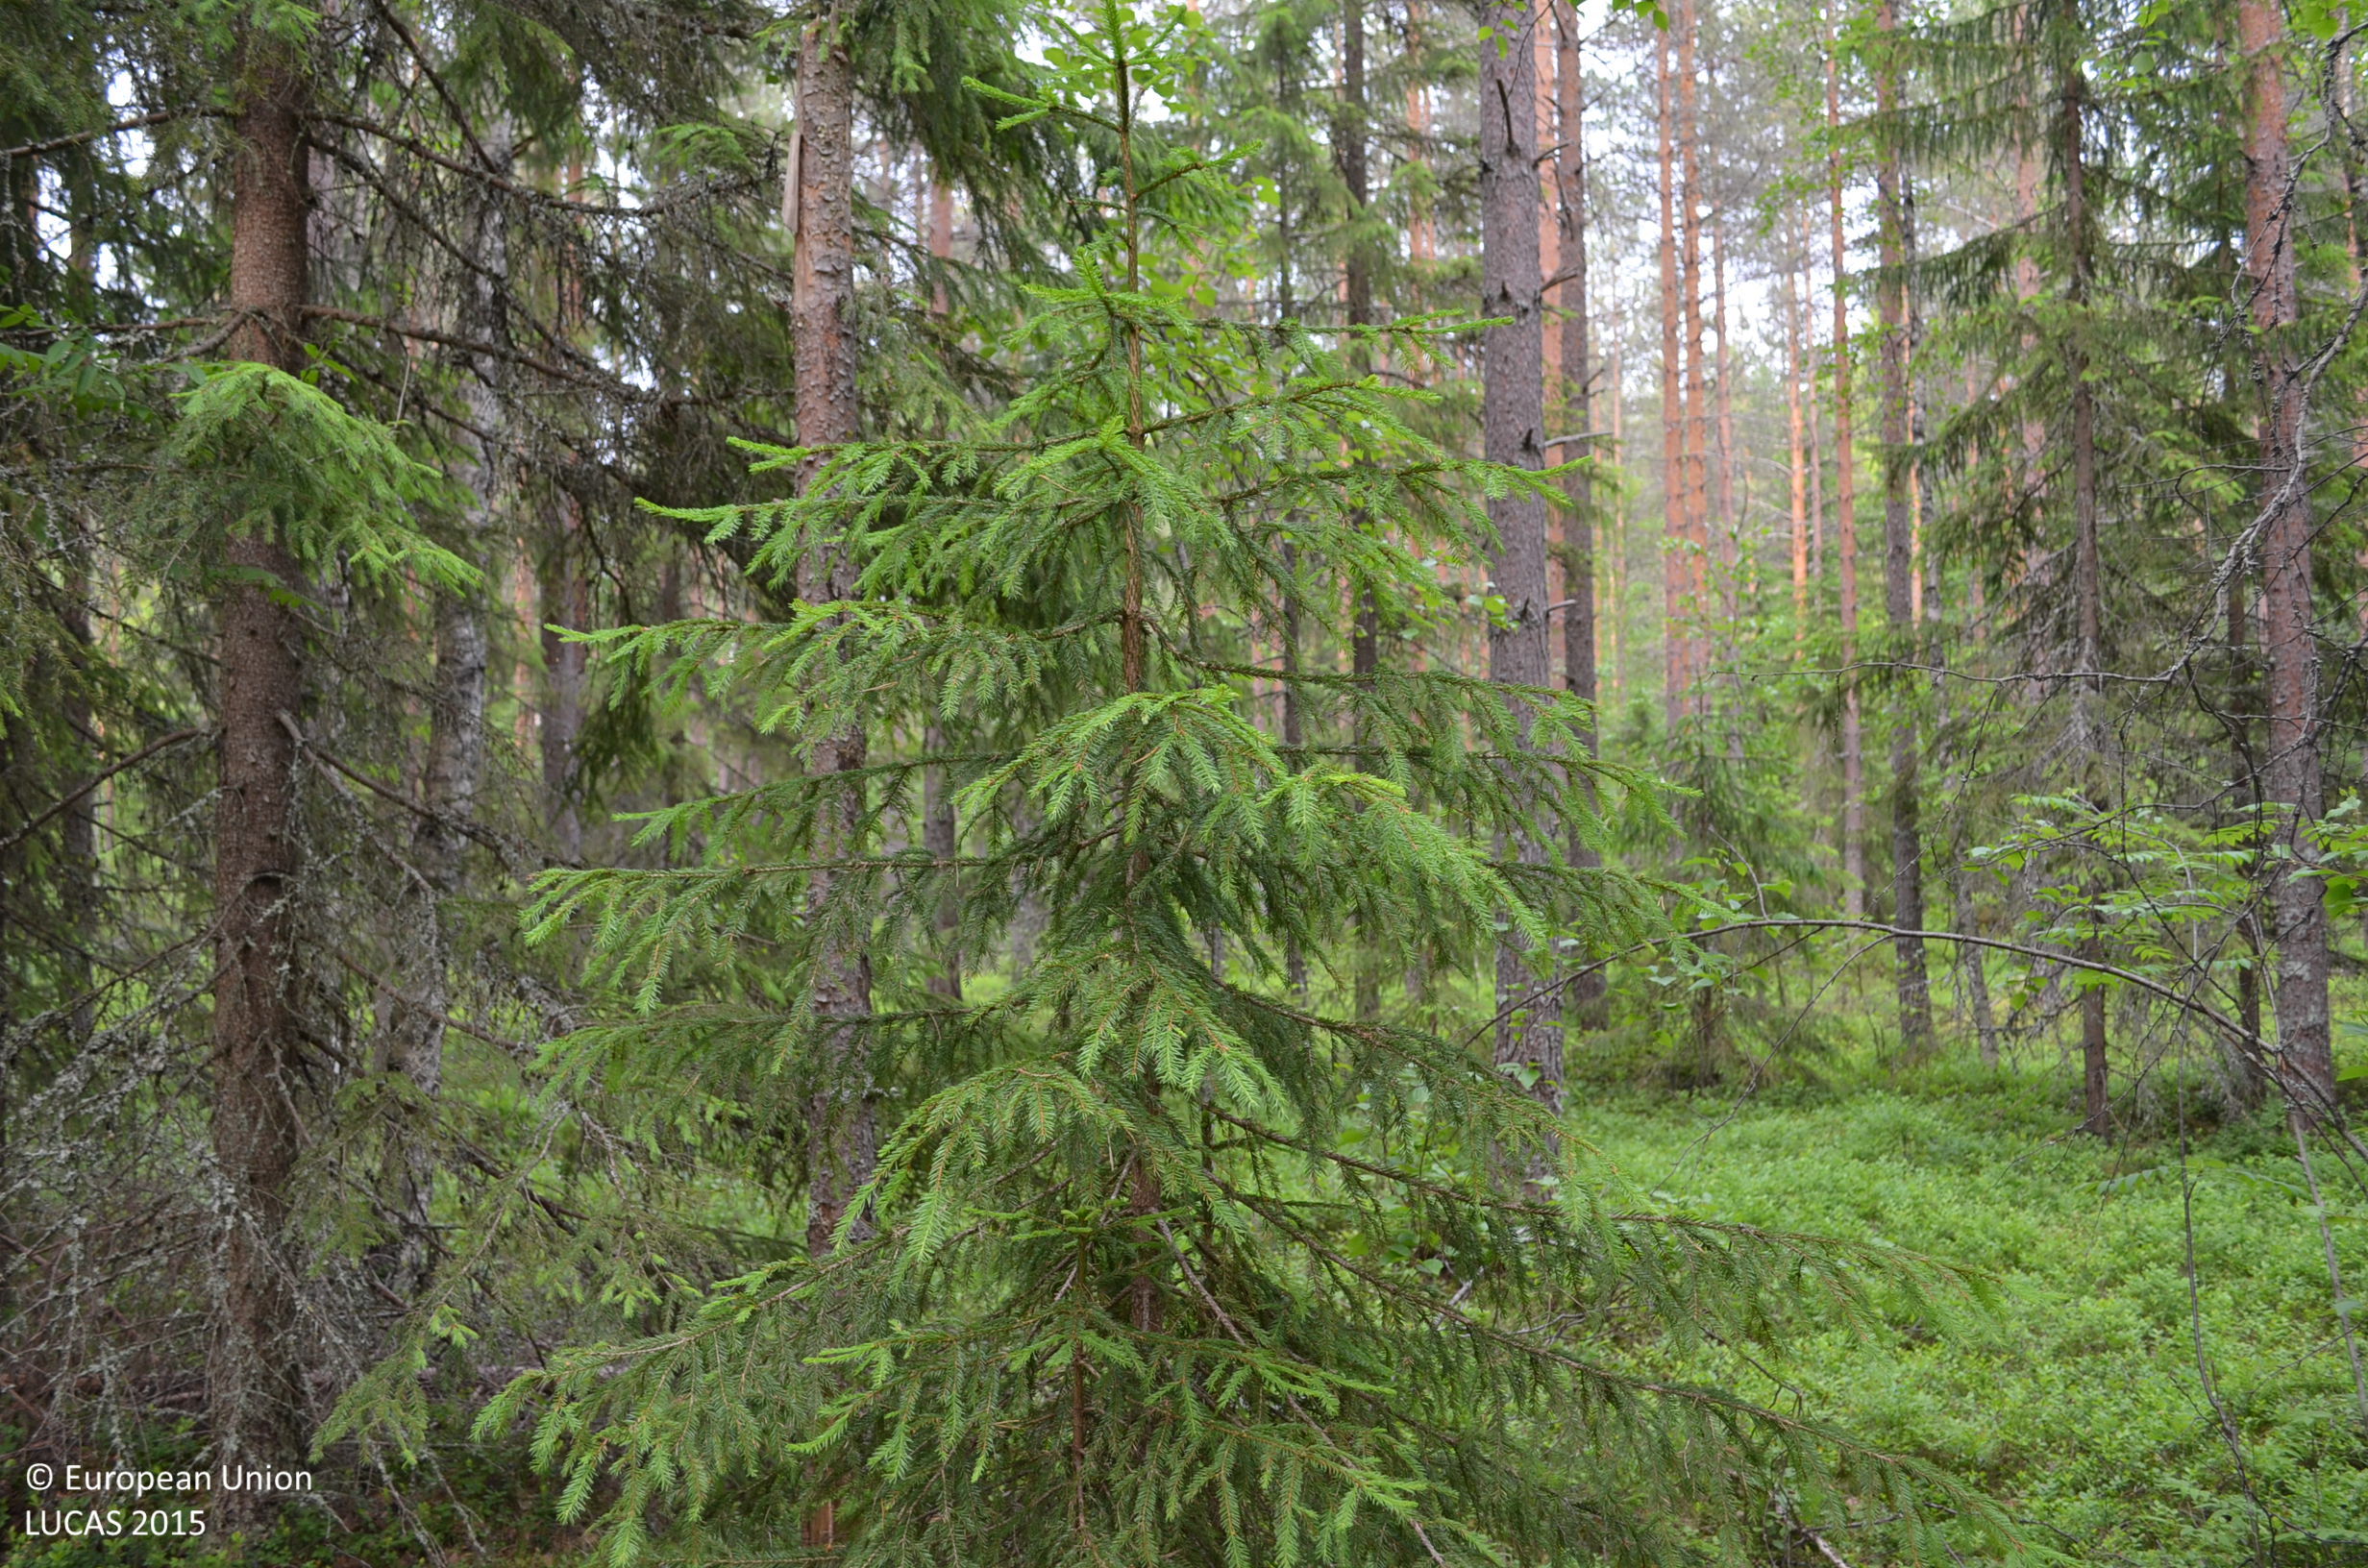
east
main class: Woodland
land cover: Other coniferous woodland
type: boreal forest
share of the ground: > 75 %
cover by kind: coniferous forest trees 60 %, broadleaved forest trees 20 %, shrubs 20 %
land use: Forestry
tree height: > 5 m
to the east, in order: Other coniferous woodland; Pine dominated coniferous woodland; Ditches and canals; Abandoned hedges; Paved roads, cycling and walking lanes; Abandoned hedges; Ditches and canals; Other coniferous woodland; Pine dominated mixed woodland; Other mixed woodland; Ditches and canals; Other mixed woodland; Ditches and canals; Other mixed woodland
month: June
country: FI
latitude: 62.0924
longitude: 23.5000
